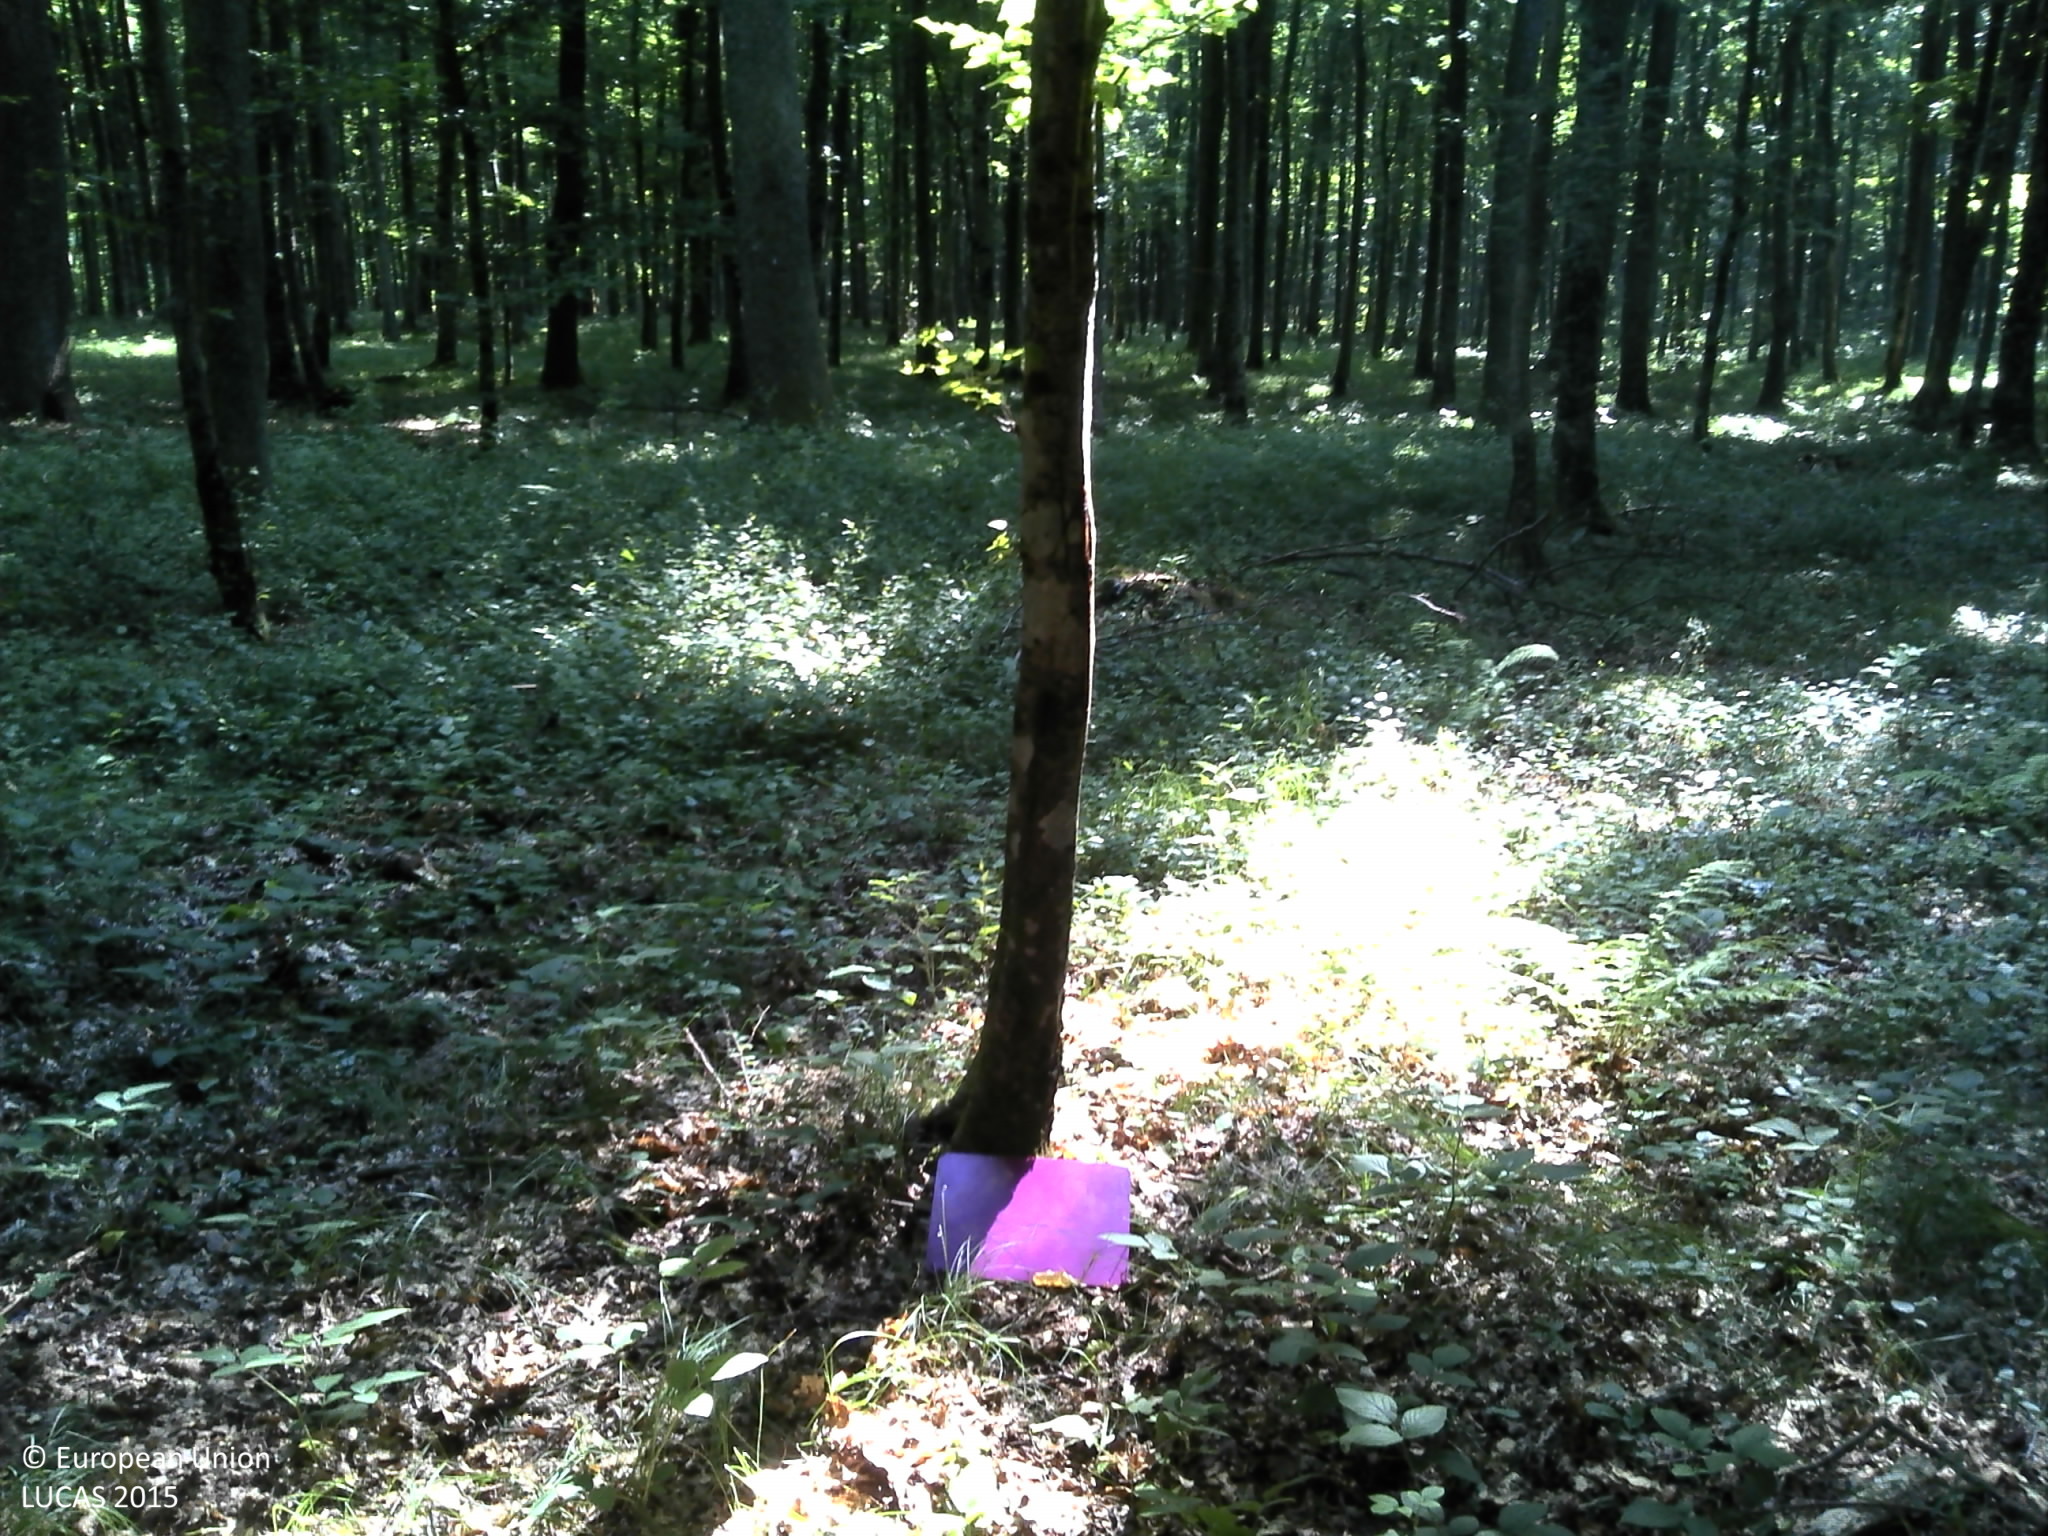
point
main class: Woodland
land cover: Broadleaved woodland
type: mesophytic deciduous forest
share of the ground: > 75 %
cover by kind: broadleaved forest trees 90 %, shrubs 5 %, herbaceous plants 5 %
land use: Forestry
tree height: > 5 m
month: July
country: HR
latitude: 45.7908
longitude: 16.5212
